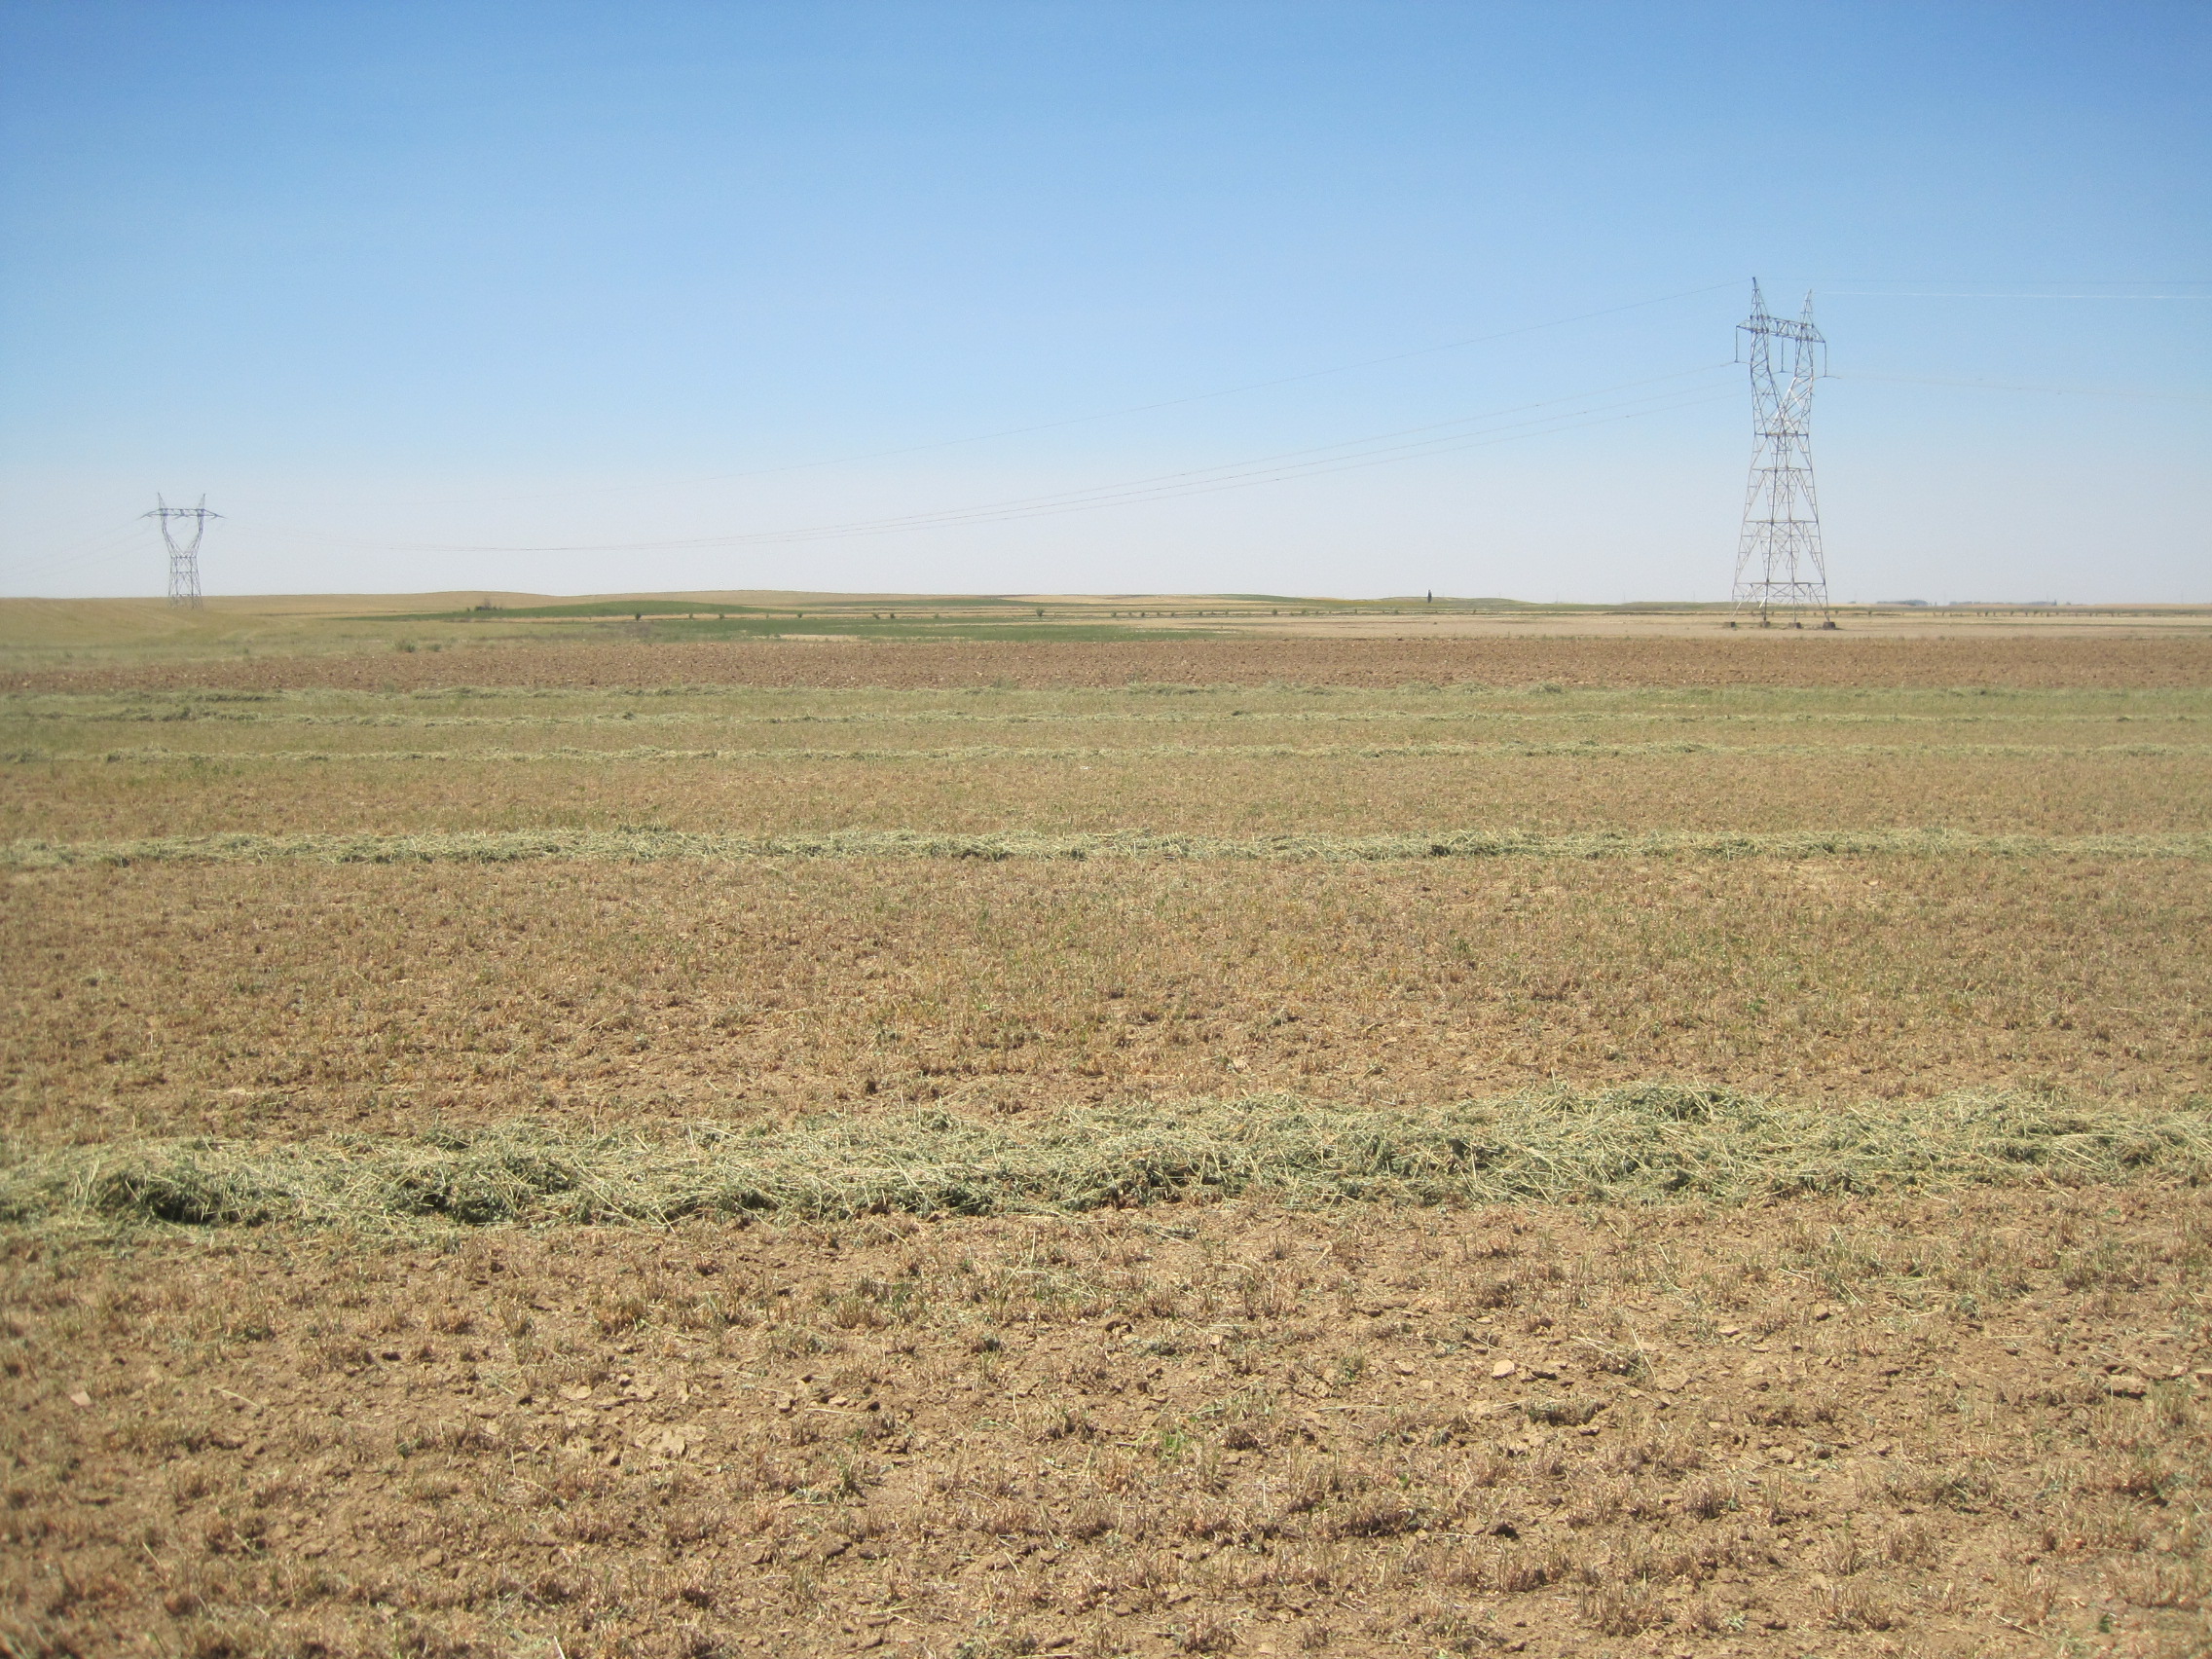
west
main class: Cropland
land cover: Lucerne
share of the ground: < 10 %
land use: Agriculture (excluding fallow land and kitchen gardens)
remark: Harvested field
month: July
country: ES
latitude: 41.9904
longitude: -4.7398
